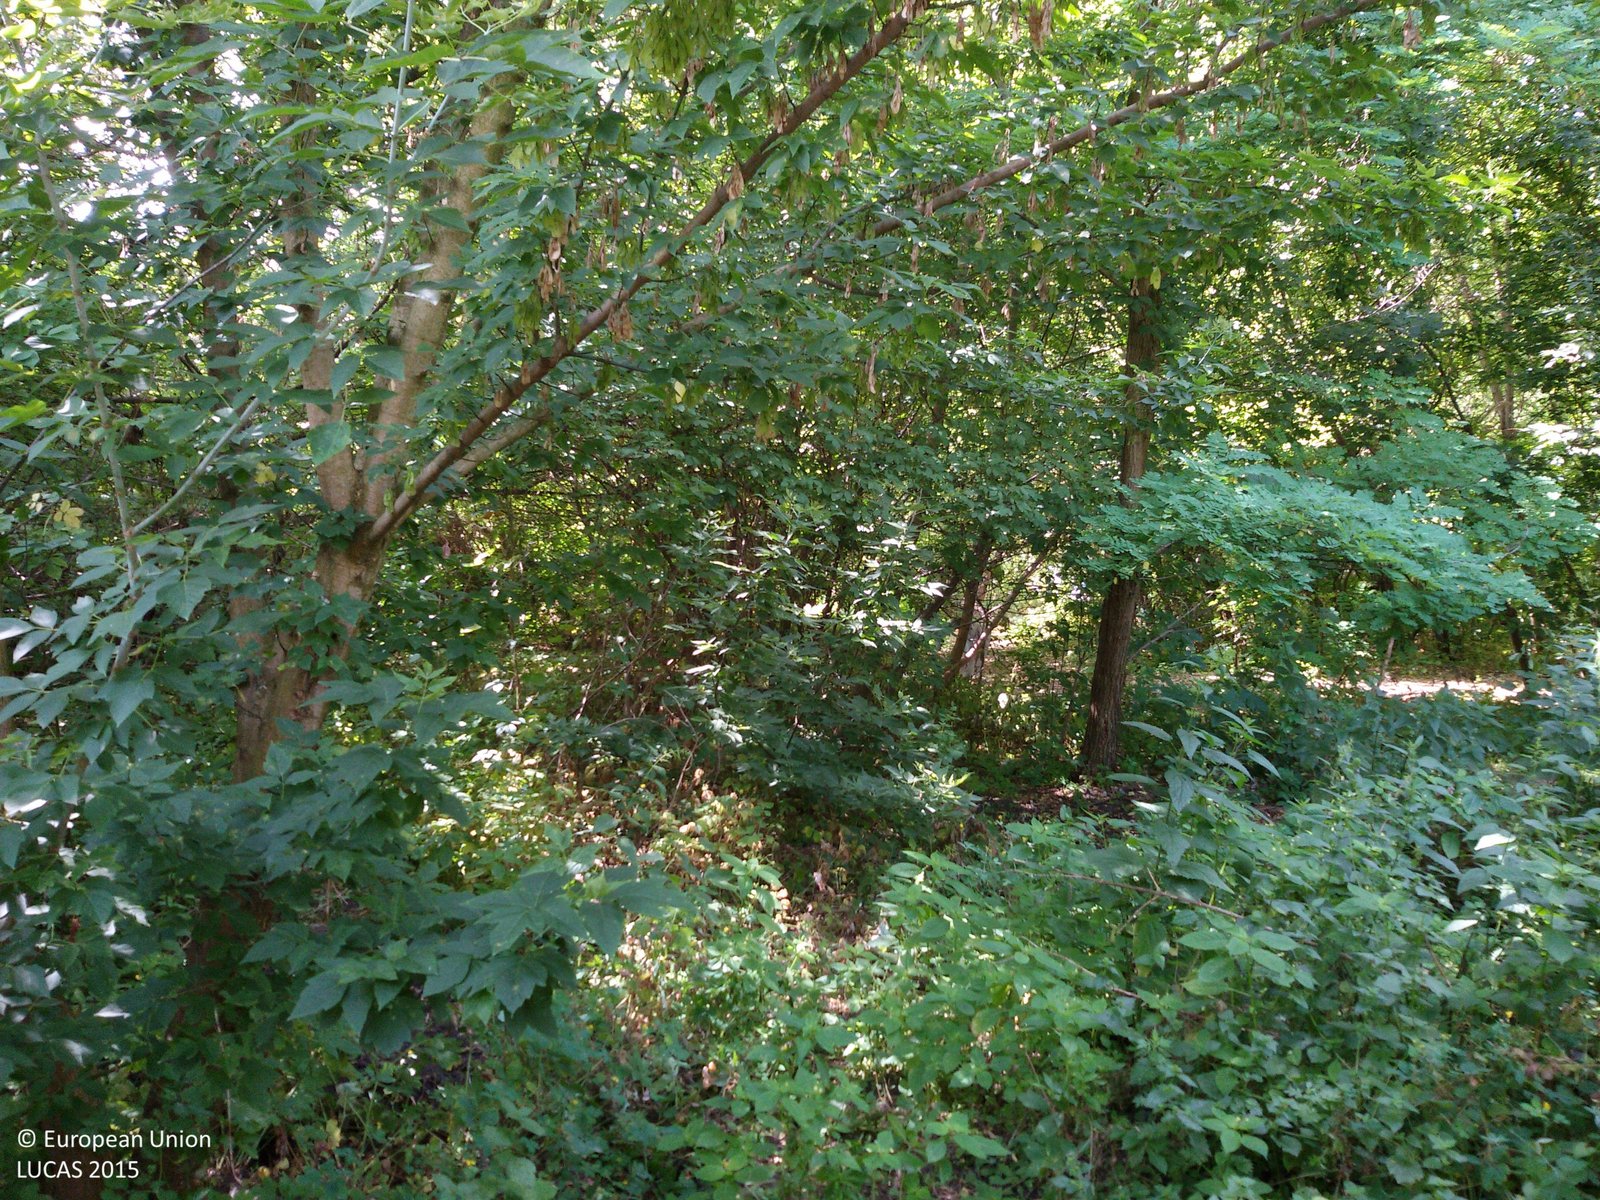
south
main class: Woodland
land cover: Broadleaved woodland
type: mesophytic deciduous forest
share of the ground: 25 - 50 %
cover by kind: herbaceous plants 60 %, broadleaved forest trees 25 %, shrubs 15 %
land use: Semi-natural and natural areas not in use
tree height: < 5 m
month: July
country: PL
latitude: 52.6439
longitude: 19.0833
